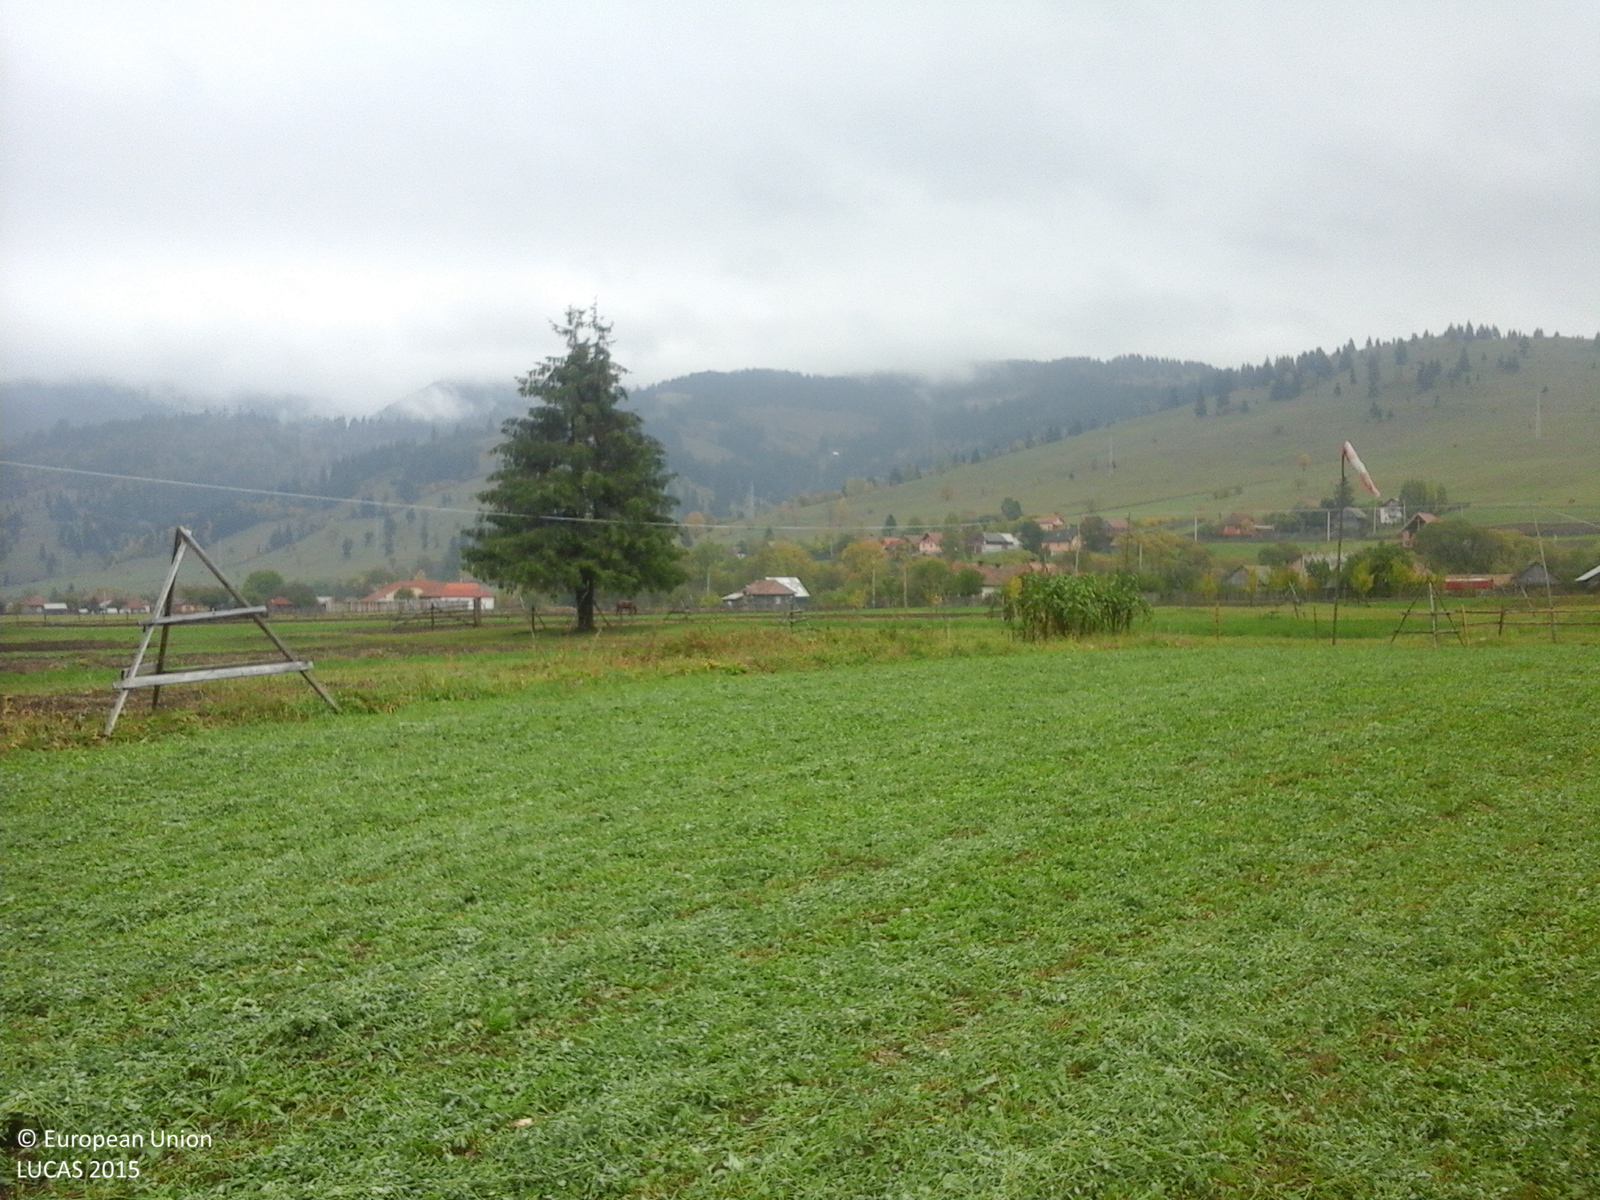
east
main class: Cropland
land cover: Lucerne
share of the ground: > 75 %
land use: Agriculture (excluding fallow land and kitchen gardens)
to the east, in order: Lucerne; Grassland without tree/shrub cover; Tracks; Fences; Lucerne; Fences; Lucerne; Fences; Potatoes; Grassland without tree/shrub cover; Lucerne; Grassland without tree/shrub cover; Potatoes; Fences; Grassland without tree/shrub cover
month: October
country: RO
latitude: 46.5719
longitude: 25.9736
